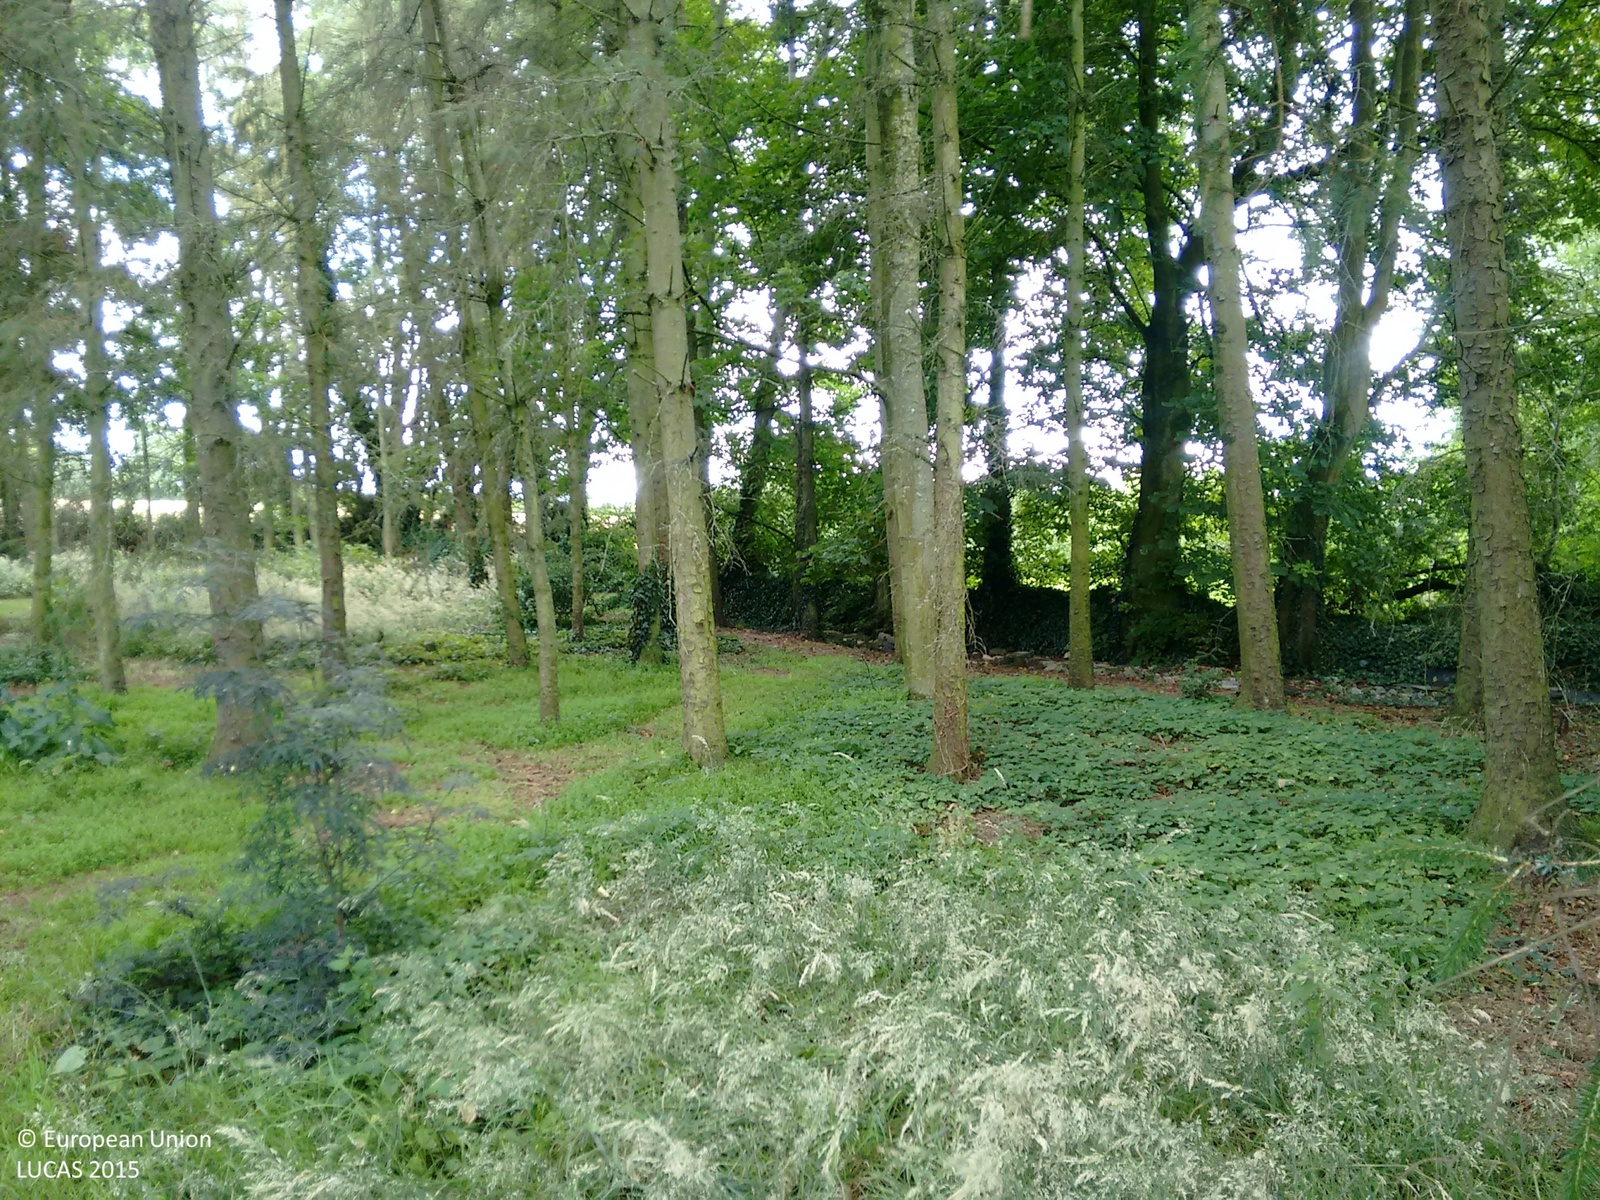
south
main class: Woodland
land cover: Spruce dominated coniferous woodland
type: hemiboreal forest and nemoral coniferous forest and mixed broadleaved-coniferous forest
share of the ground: > 75 %
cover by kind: coniferous forest trees 85 %, broadleaved forest trees 10 %, shrubs 5 %
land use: Residential
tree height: > 5 m
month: July
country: IE
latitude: 52.8265
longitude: -6.7725
